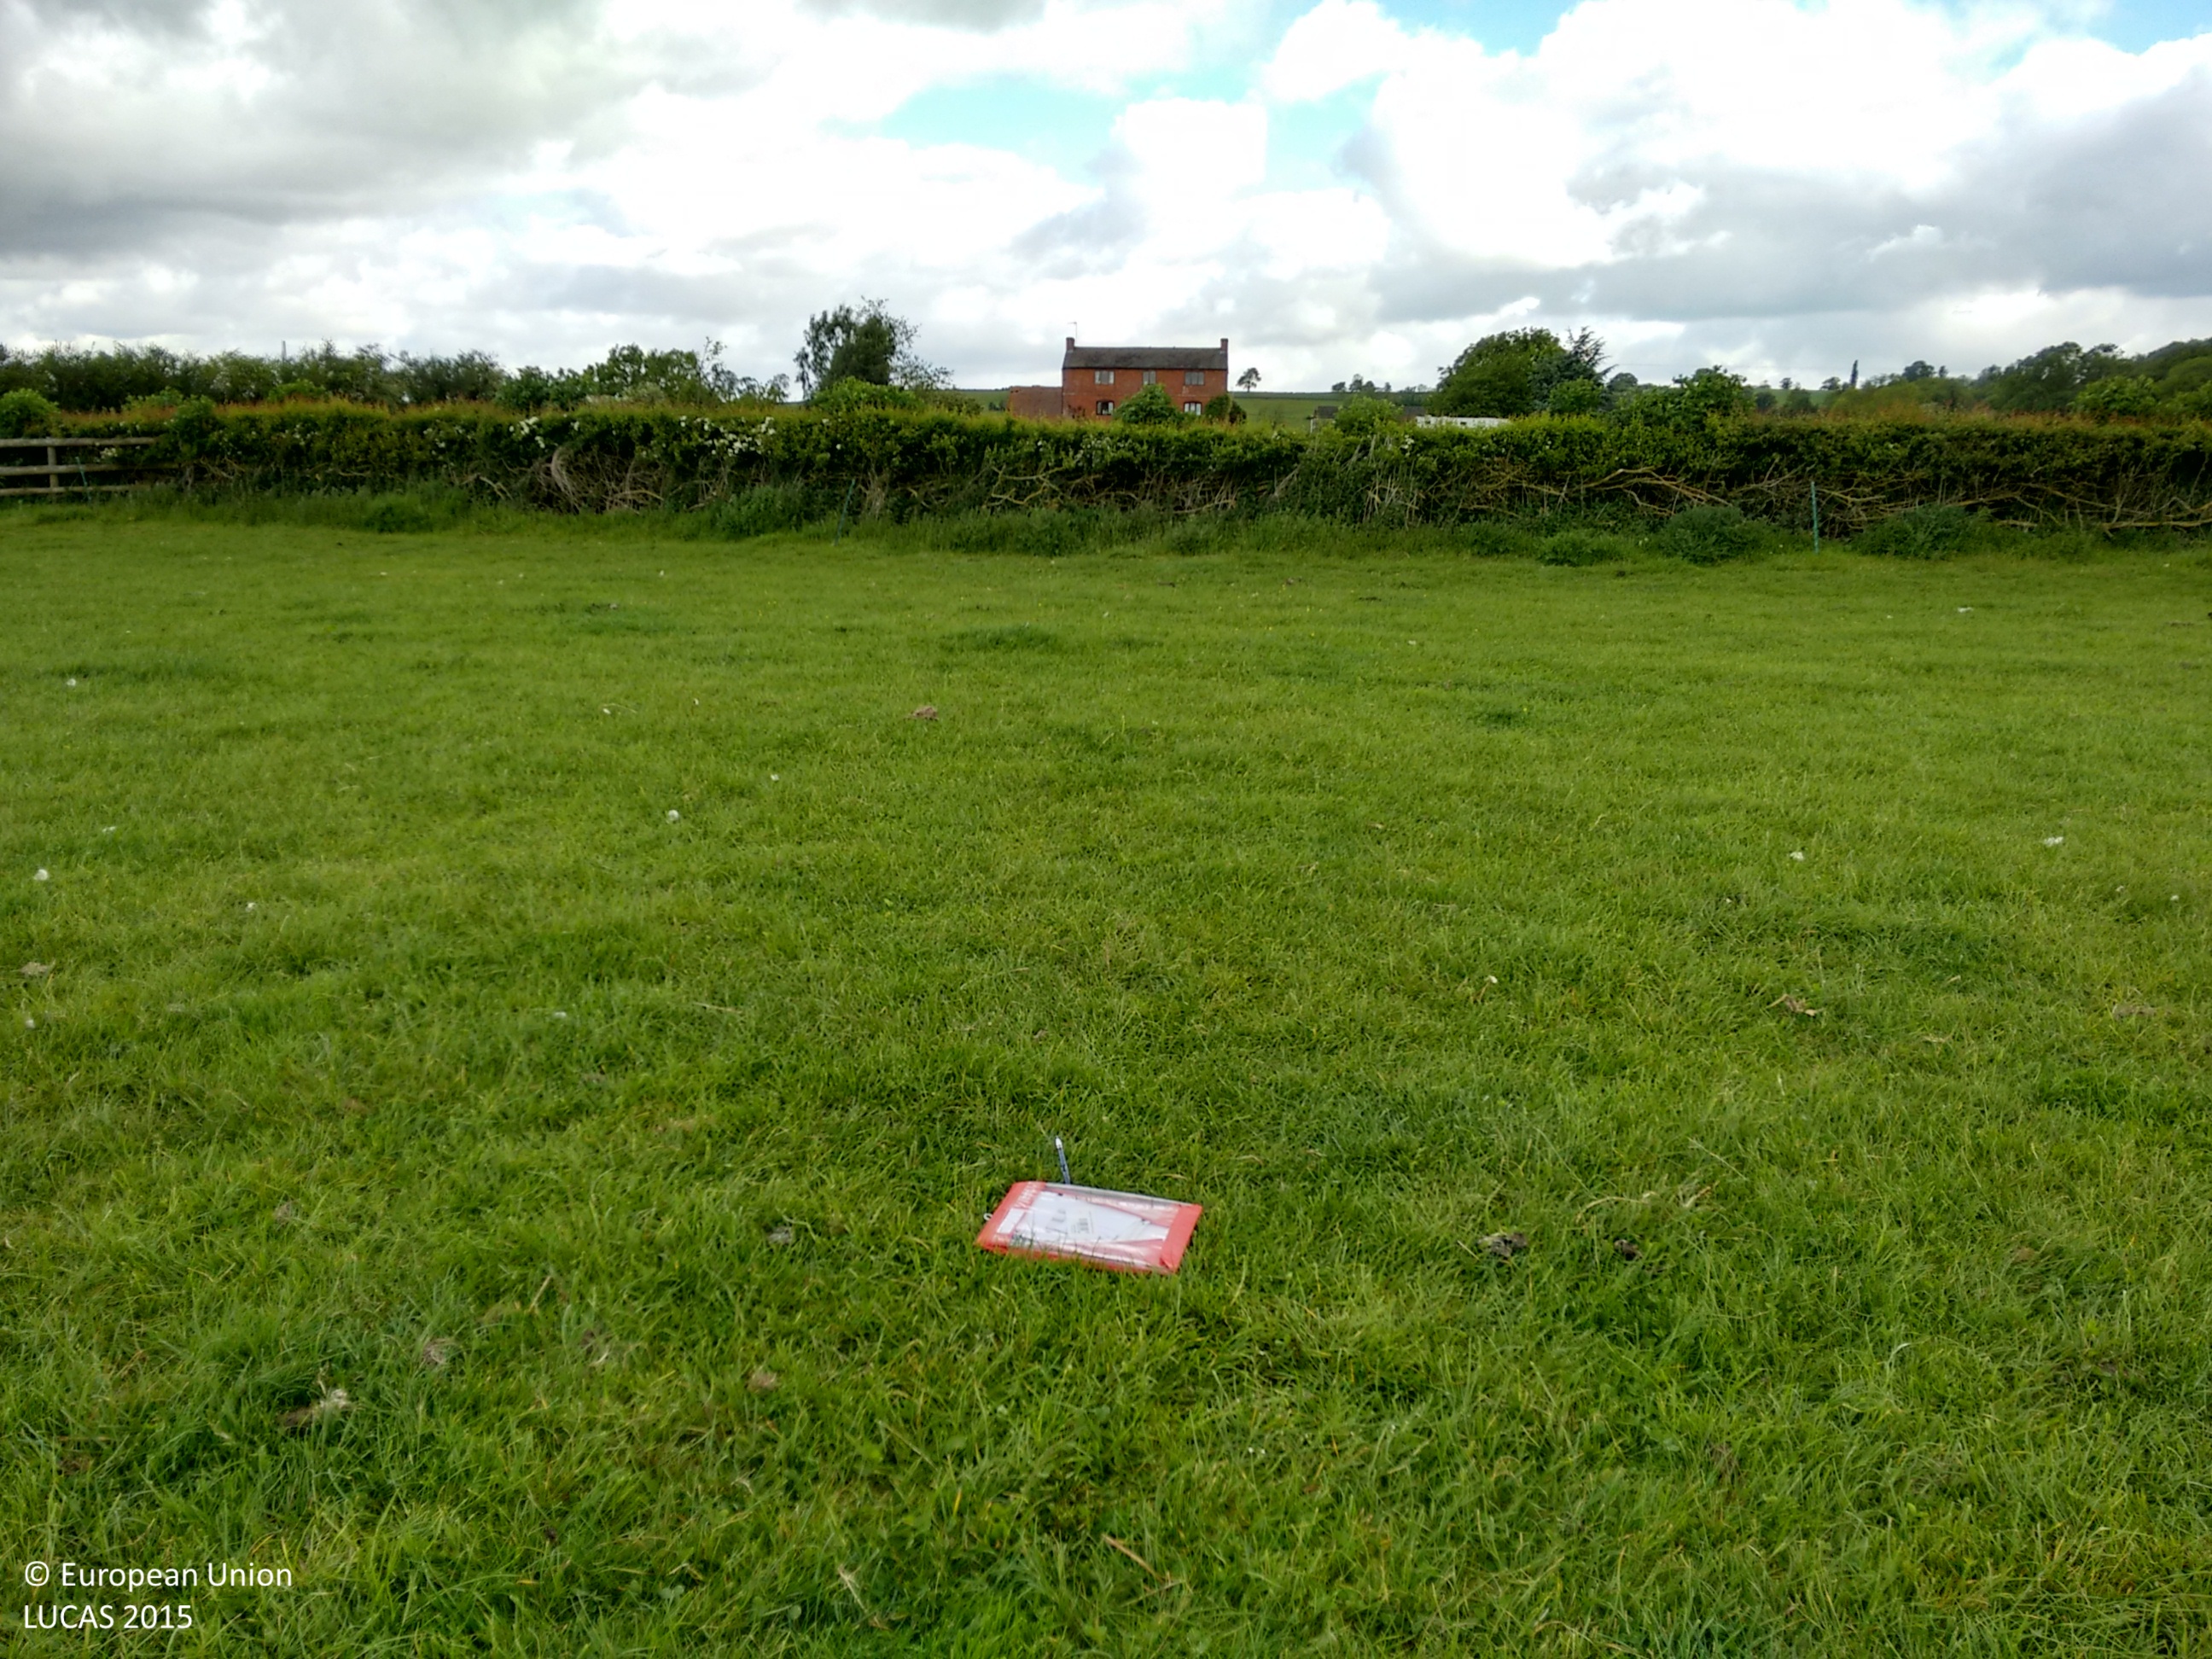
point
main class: Grassland
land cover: Grassland without tree/shrub cover
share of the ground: > 75 %
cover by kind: herbaceous plants 100 %
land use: Agriculture (excluding fallow land and kitchen gardens)
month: May
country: GB
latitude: 52.3177
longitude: -1.3894
